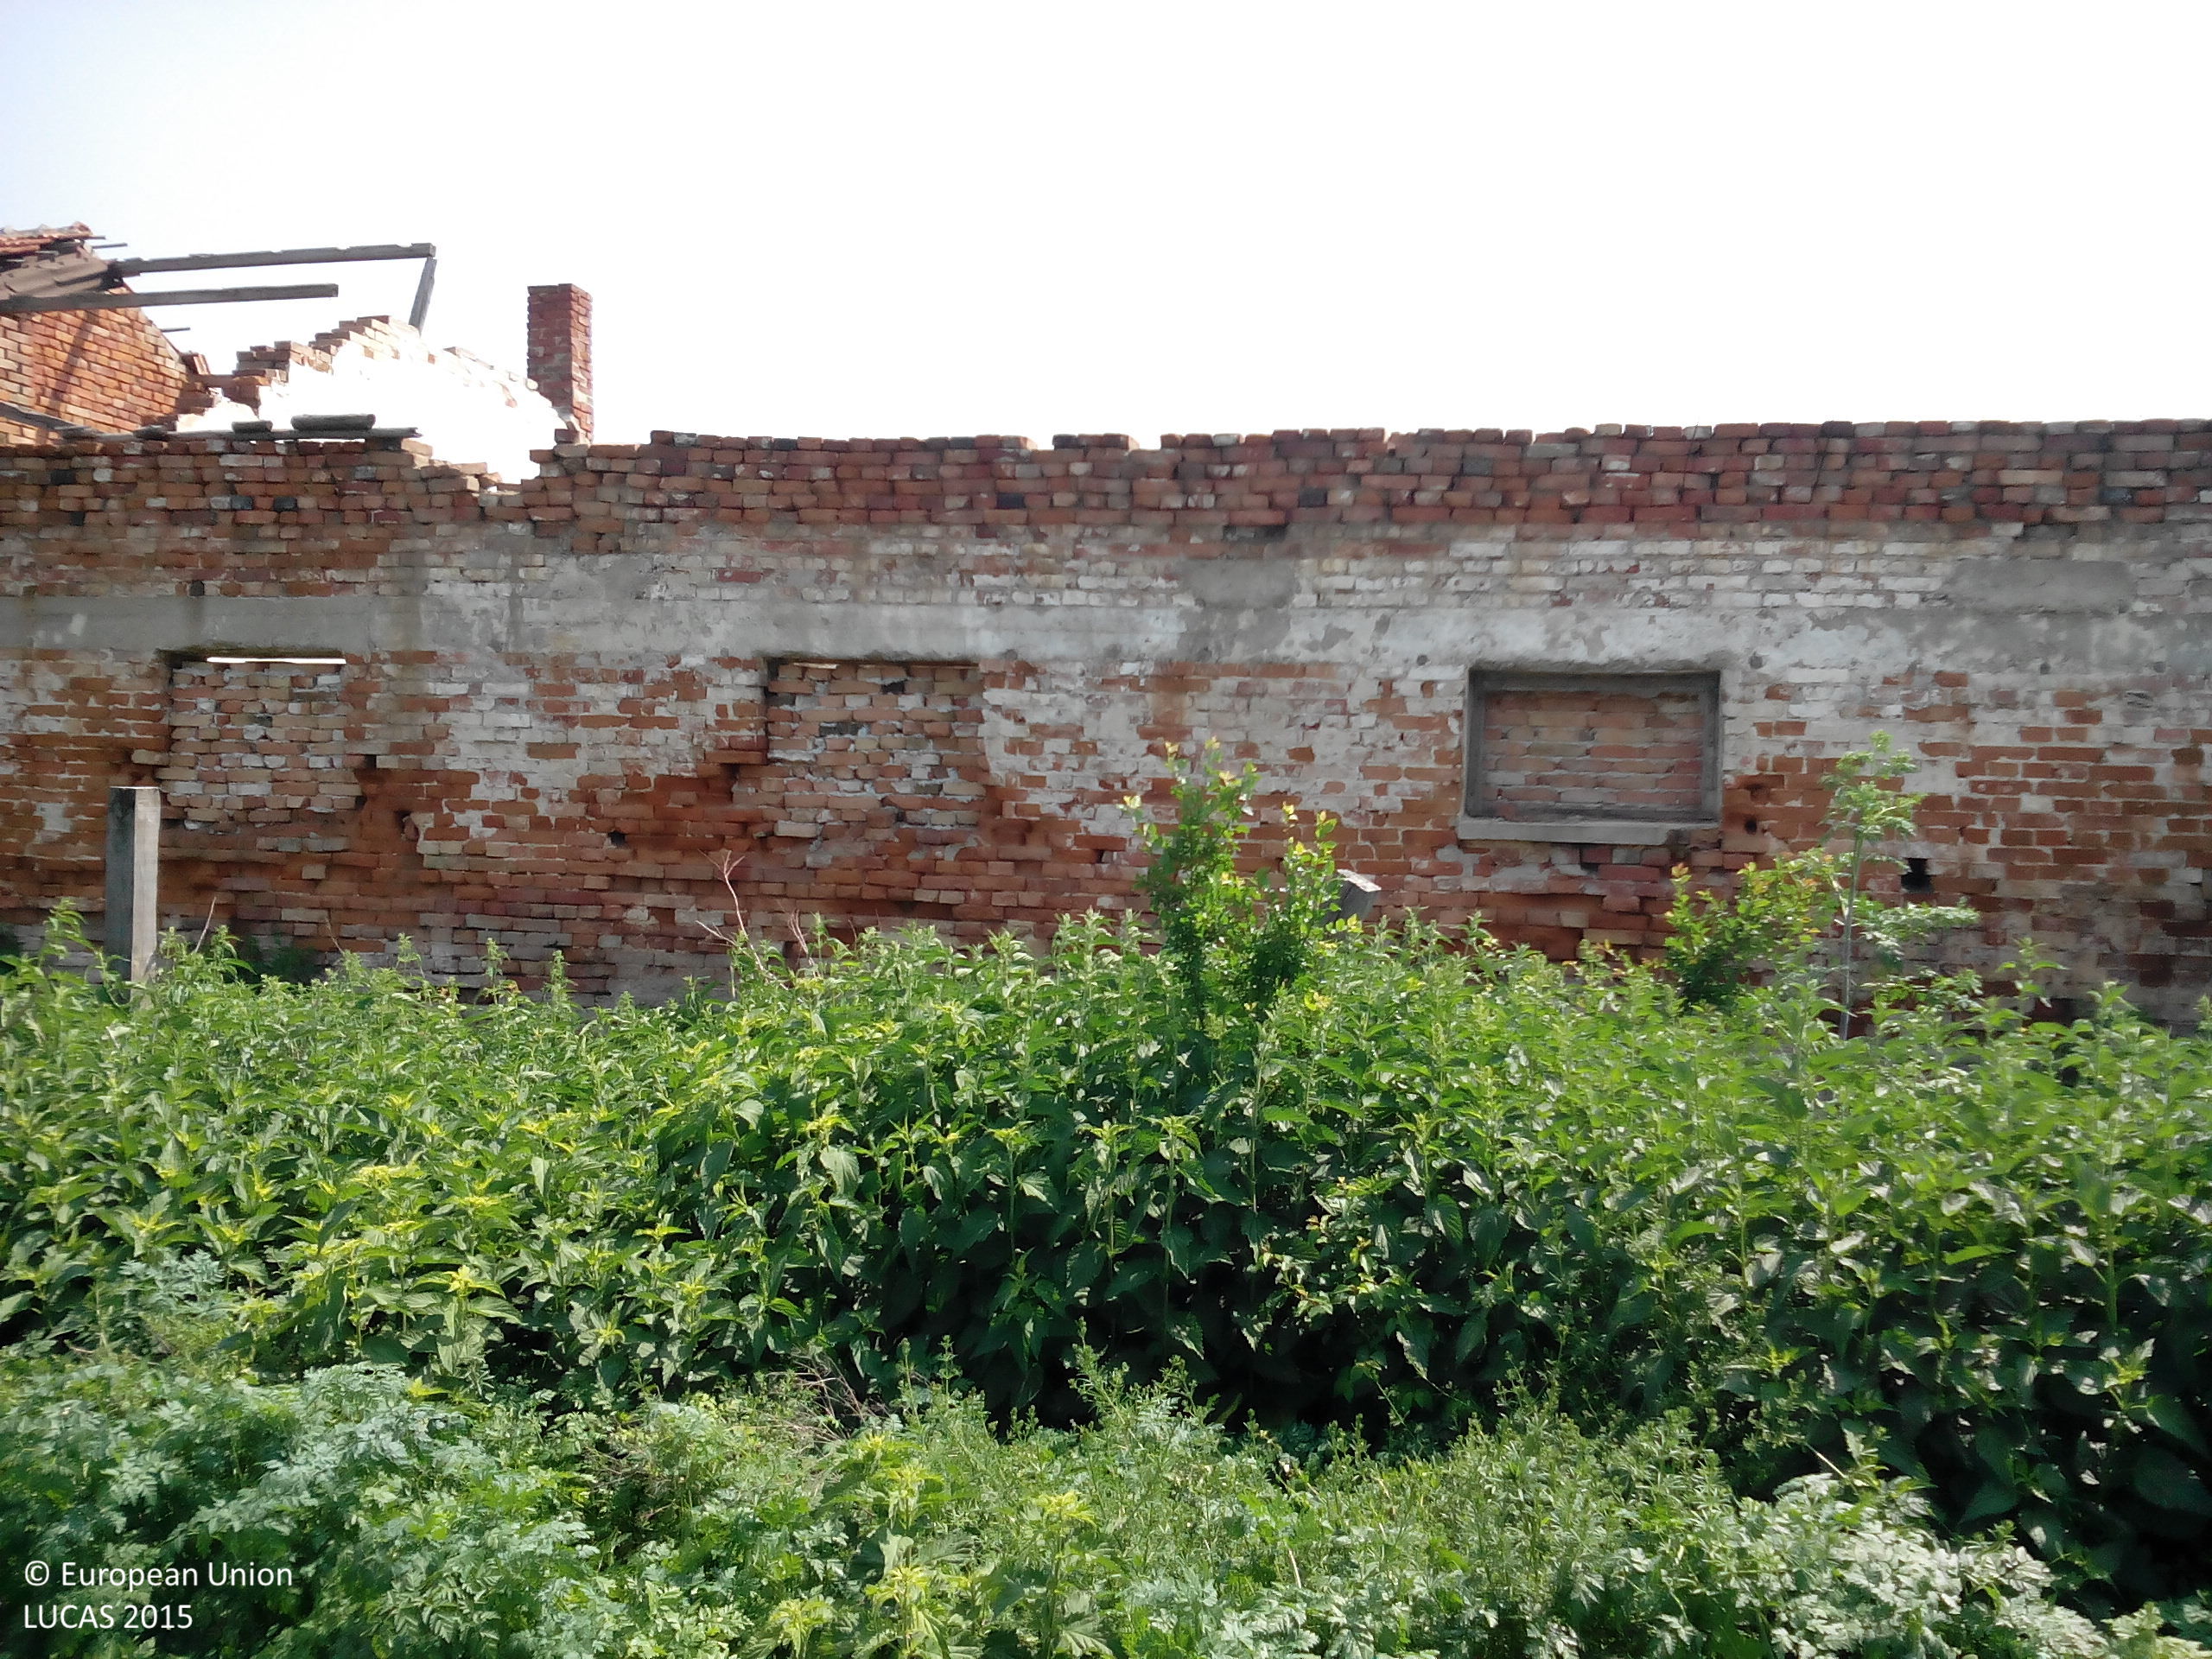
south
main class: Cropland
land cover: Sunflower
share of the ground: 25 - 50 %
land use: Agriculture (excluding fallow land and kitchen gardens)
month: May
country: BG
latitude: 43.6416
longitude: 24.0758
